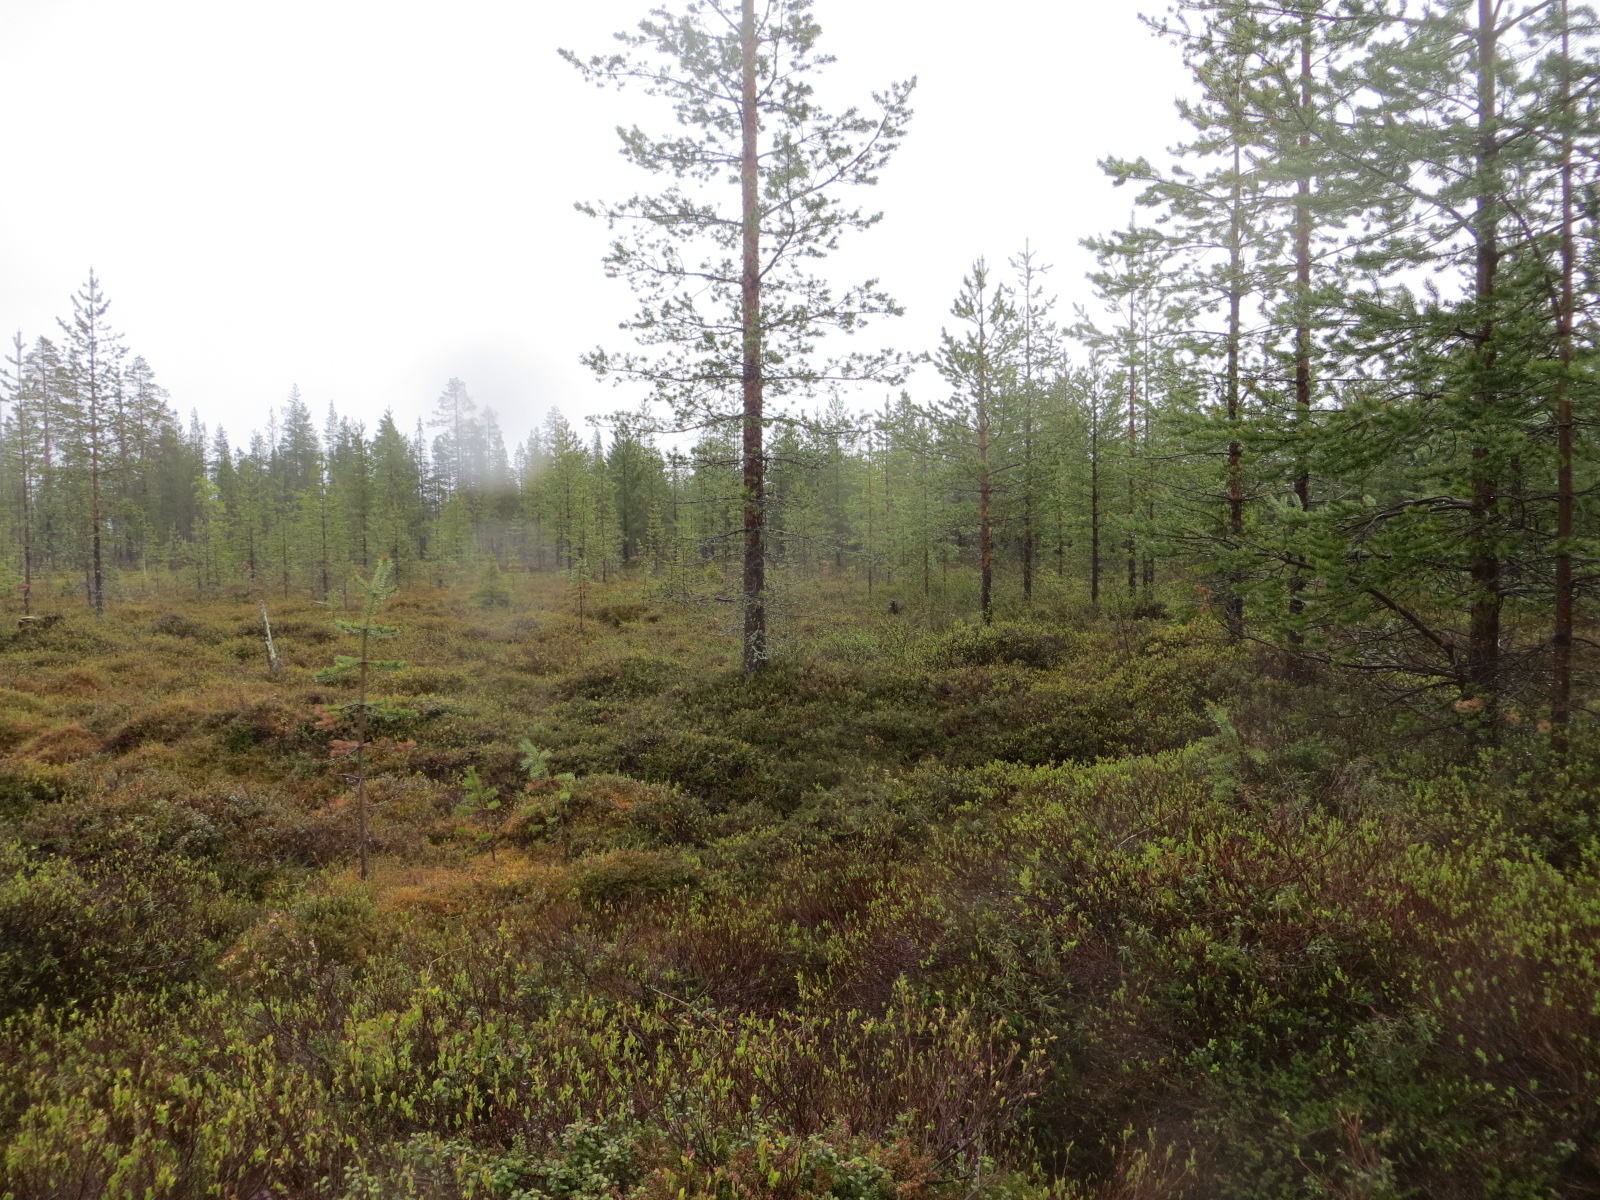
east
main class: Woodland
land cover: Pine dominated coniferous woodland
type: mire and swamp forests
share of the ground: 25 - 50 %
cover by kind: shrubs 60 %, coniferous forest trees 40 %
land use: Forestry
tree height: > 5 m
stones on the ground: < 10 %
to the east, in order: Pine dominated coniferous woodland; Ditches and canals; Pine dominated coniferous woodland; Peatbogs; Pine dominated coniferous woodland; Ditches and canals; Pine dominated coniferous woodland; Ditches and canals; Pine dominated coniferous woodland
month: June
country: FI
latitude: 66.9777
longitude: 25.9457
